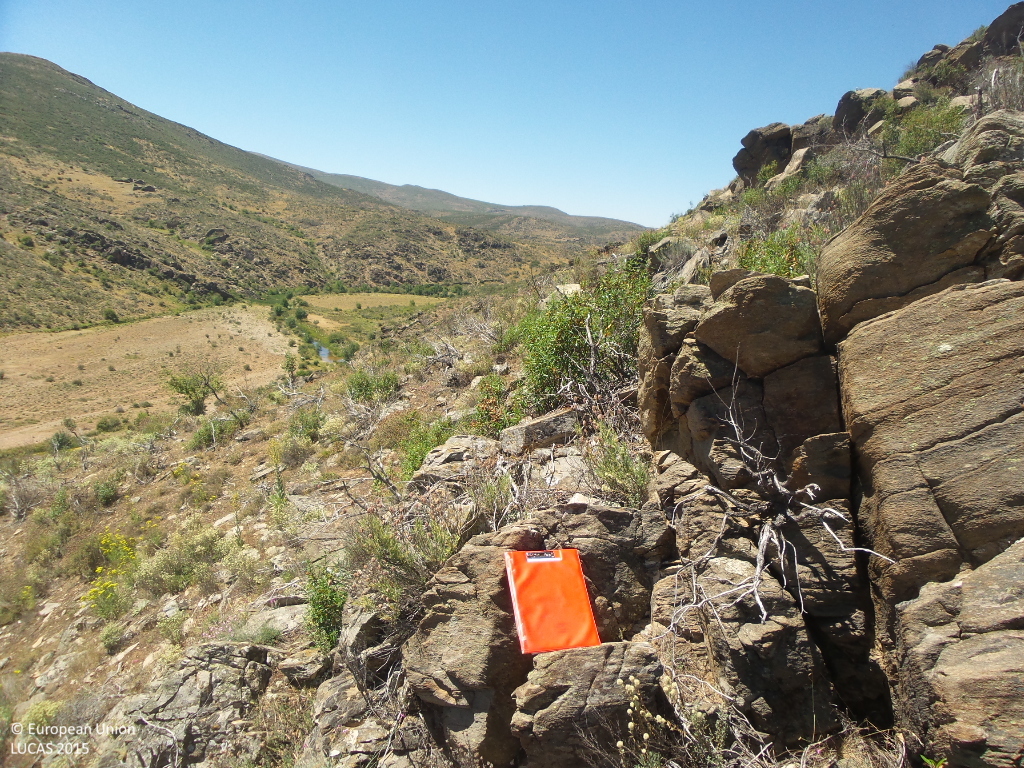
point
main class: Shrubland
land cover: Shrubland without tree cover
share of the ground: 10 - 25 %
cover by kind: consolidated bare surface 50 %, unconsolidated bare surface 30 %, shrubs 20 %
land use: Semi-natural and natural areas not in use
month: June
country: ES
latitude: 41.1293
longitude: -2.9129
